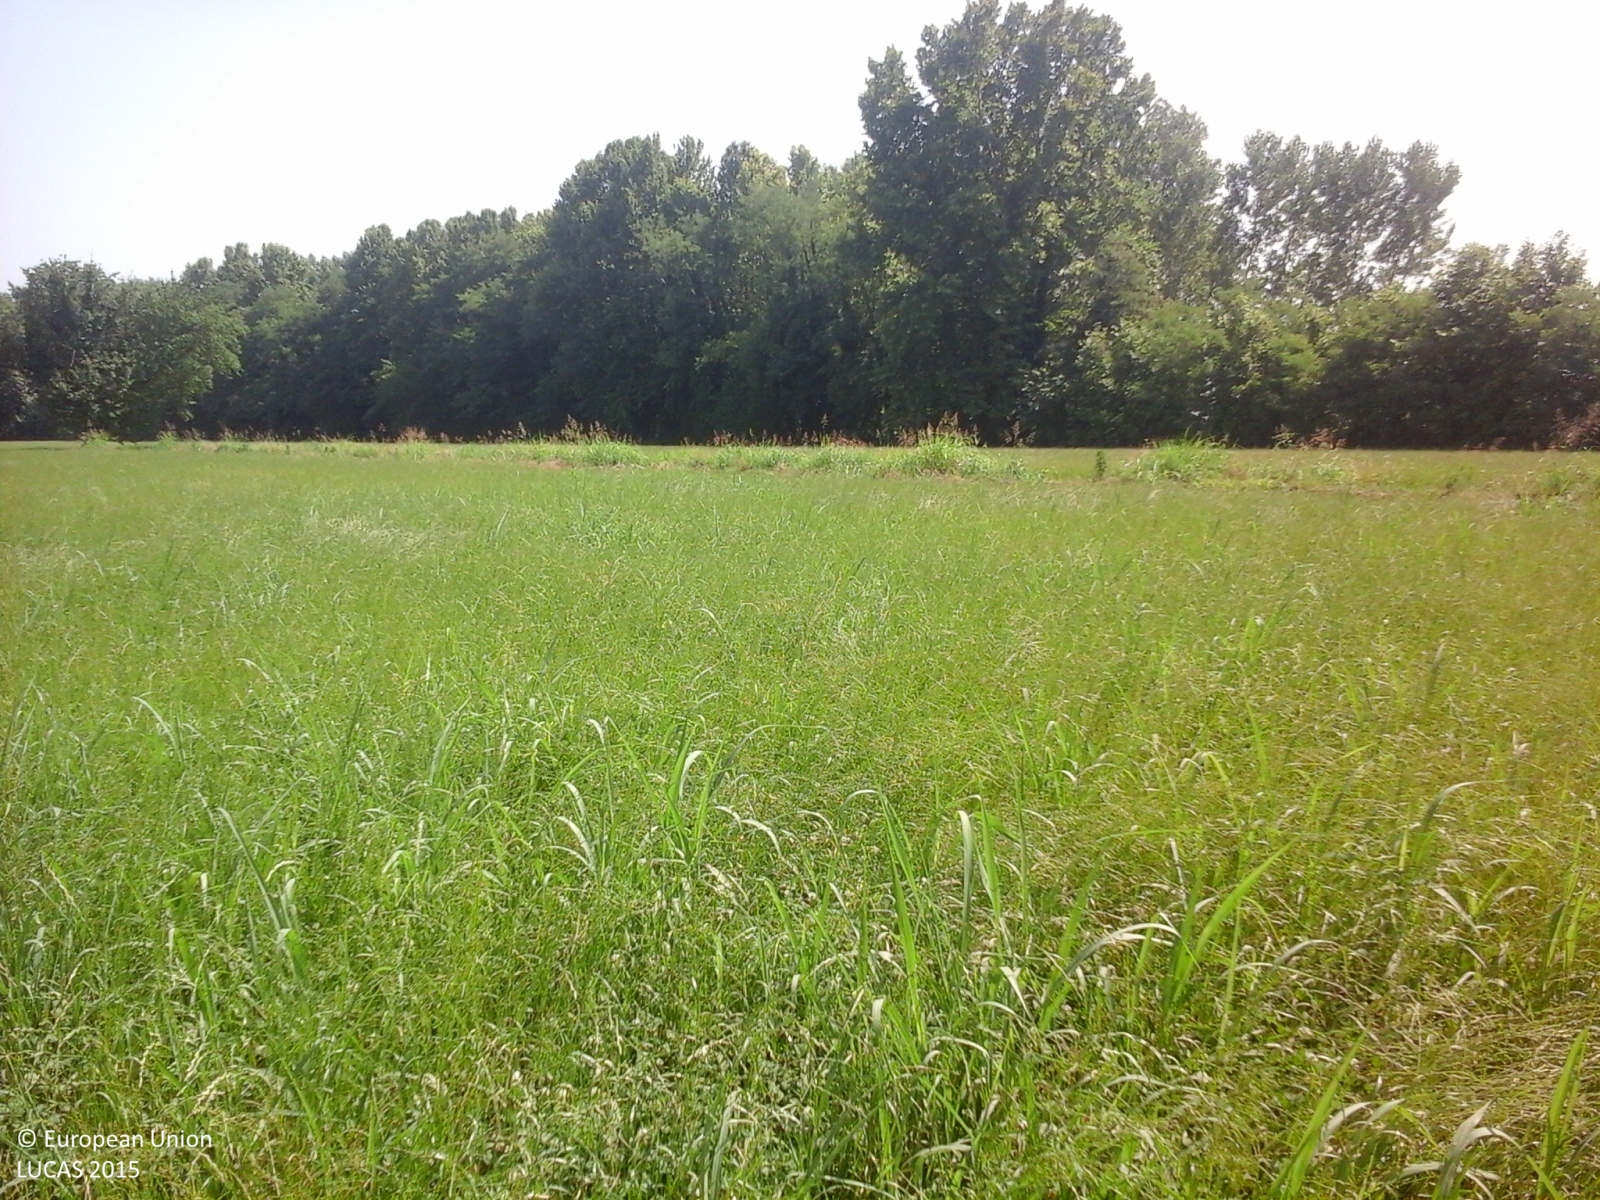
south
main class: Cropland
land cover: Temporary grasslands
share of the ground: > 75 %
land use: Agriculture (excluding fallow land and kitchen gardens)
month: July
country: IT
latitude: 45.2676
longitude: 10.7252
